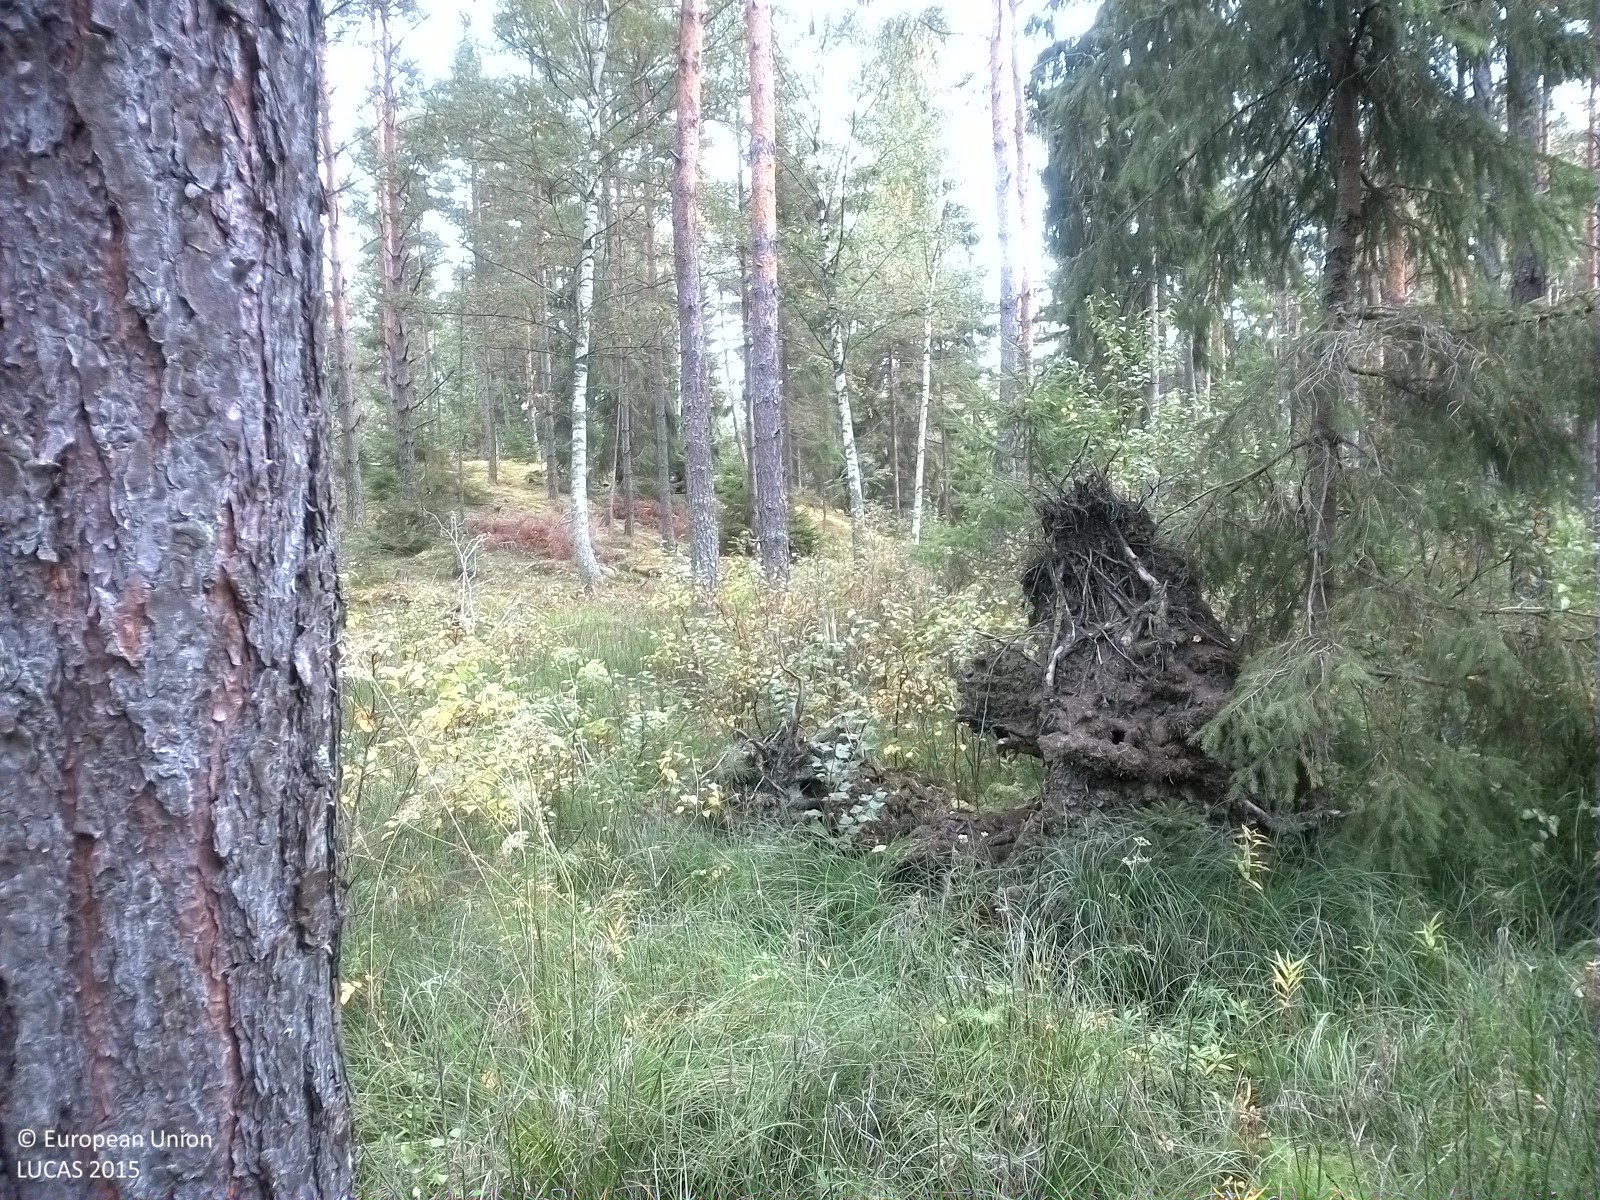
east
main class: Woodland
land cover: Pine dominated mixed woodland
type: boreal forest
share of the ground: 25 - 50 %
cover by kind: herbaceous plants 35 %, lichens and mosses 25 %, coniferous forest trees 20 %, broadleaved forest trees 15 %, shrubs 5 %
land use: Semi-natural and natural areas not in use
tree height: > 5 m
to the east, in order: Pine dominated mixed woodland; Pine dominated coniferous woodland; Spruce dominated coniferous woodland; Pine dominated coniferous woodland; Other bare soil; Pine dominated coniferous woodland
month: September
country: SE
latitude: 58.5347
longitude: 16.4369
